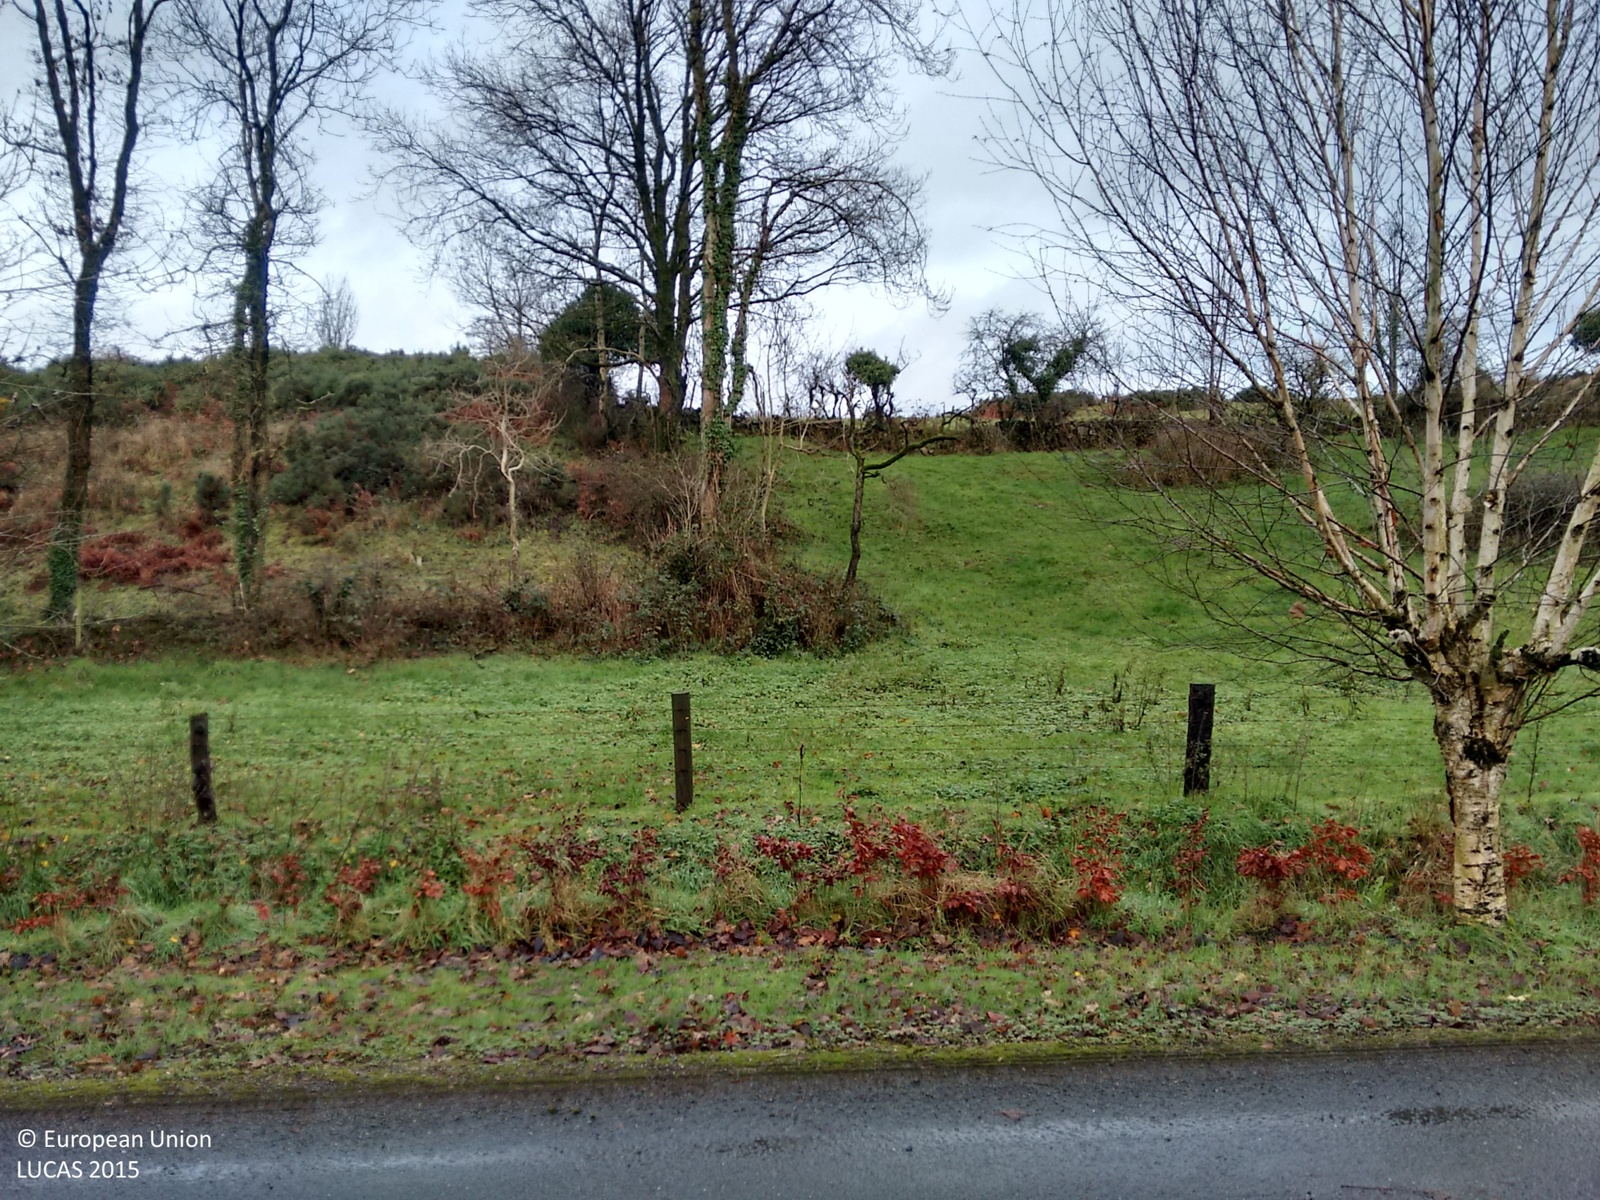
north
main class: Woodland
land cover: Broadleaved woodland
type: acidophilous oak and oak-birch forest
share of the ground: > 75 %
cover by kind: broadleaved forest trees 95 %, shrubs 5 %
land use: Semi-natural and natural areas not in use
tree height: > 5 m
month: December
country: IE
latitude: 53.9834
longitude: -7.1804
